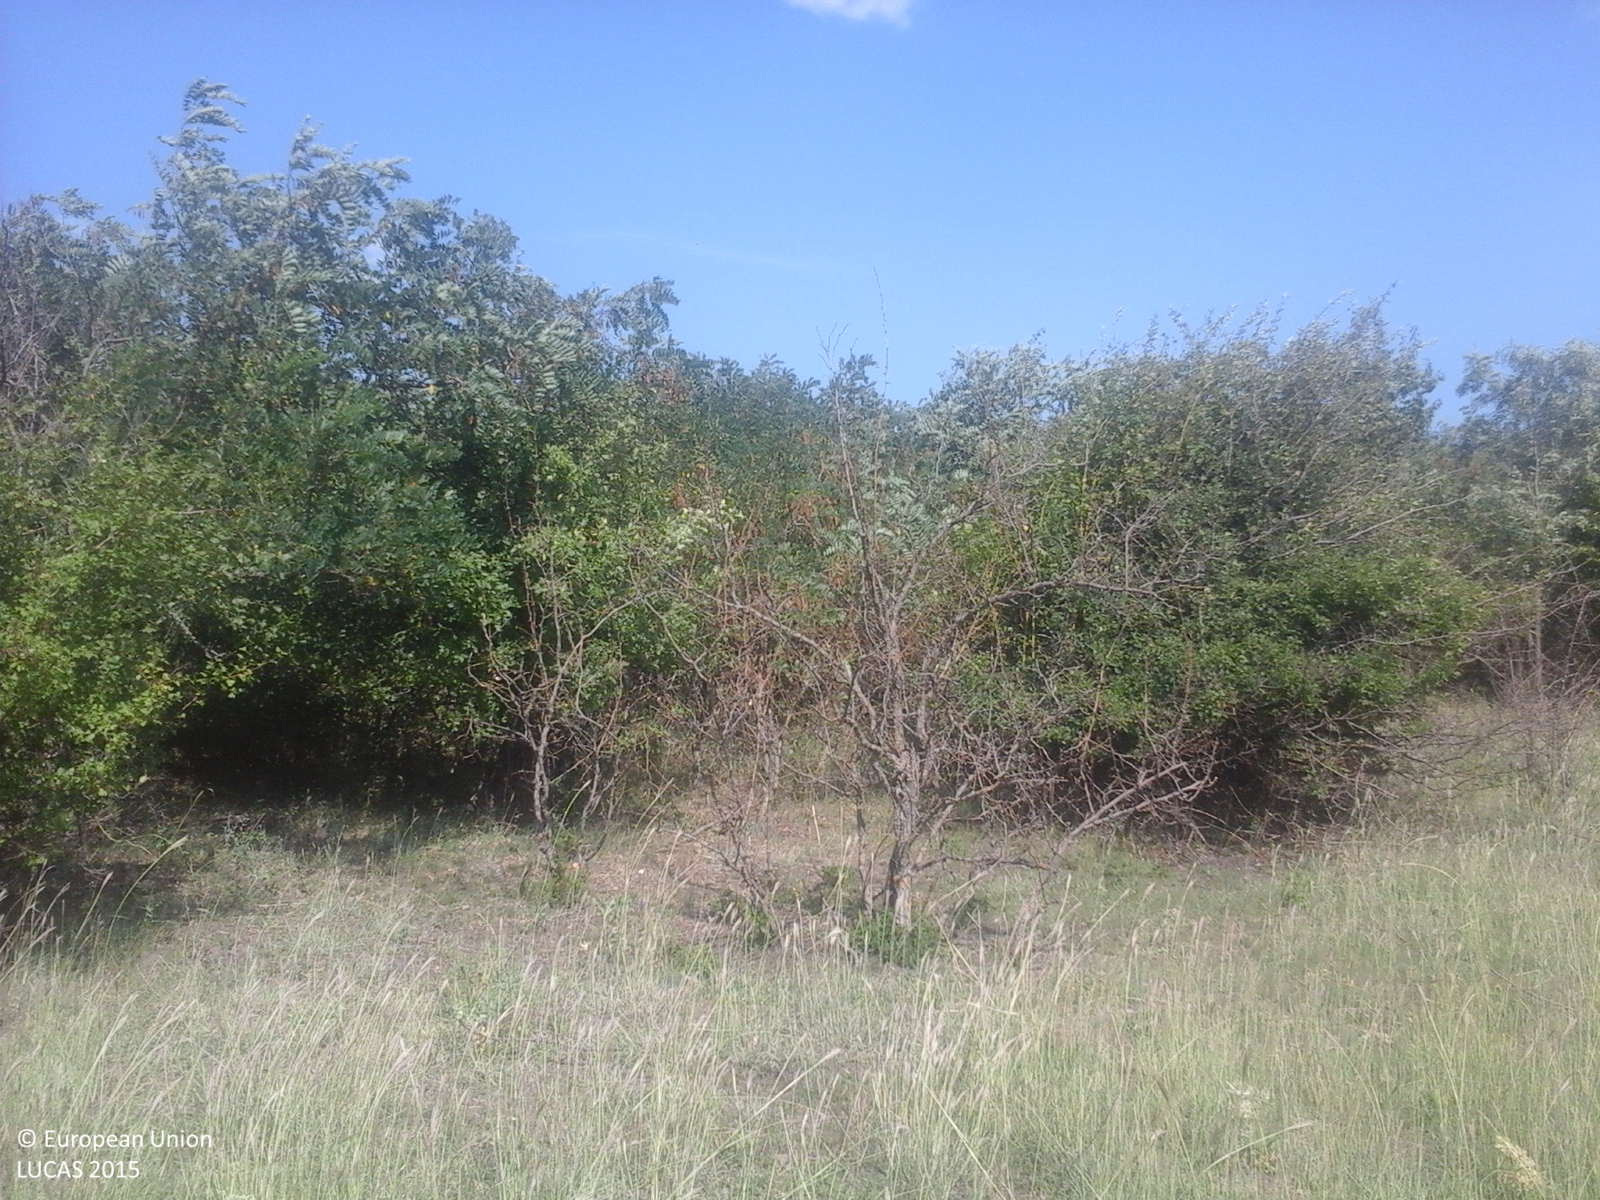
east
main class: Grassland
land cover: Grassland with sparse tree/shrub cover
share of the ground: > 75 %
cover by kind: herbaceous plants 85 %, shrubs 10 %, broadleaved forest trees 5 %
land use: Agriculture (excluding fallow land and kitchen gardens)
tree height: < 5 m
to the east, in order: Grassland with sparse tree/shrub cover; Shrubland without tree cover; Grass margins; Sunflower
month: July
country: RO
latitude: 46.4879
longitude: 27.9864
